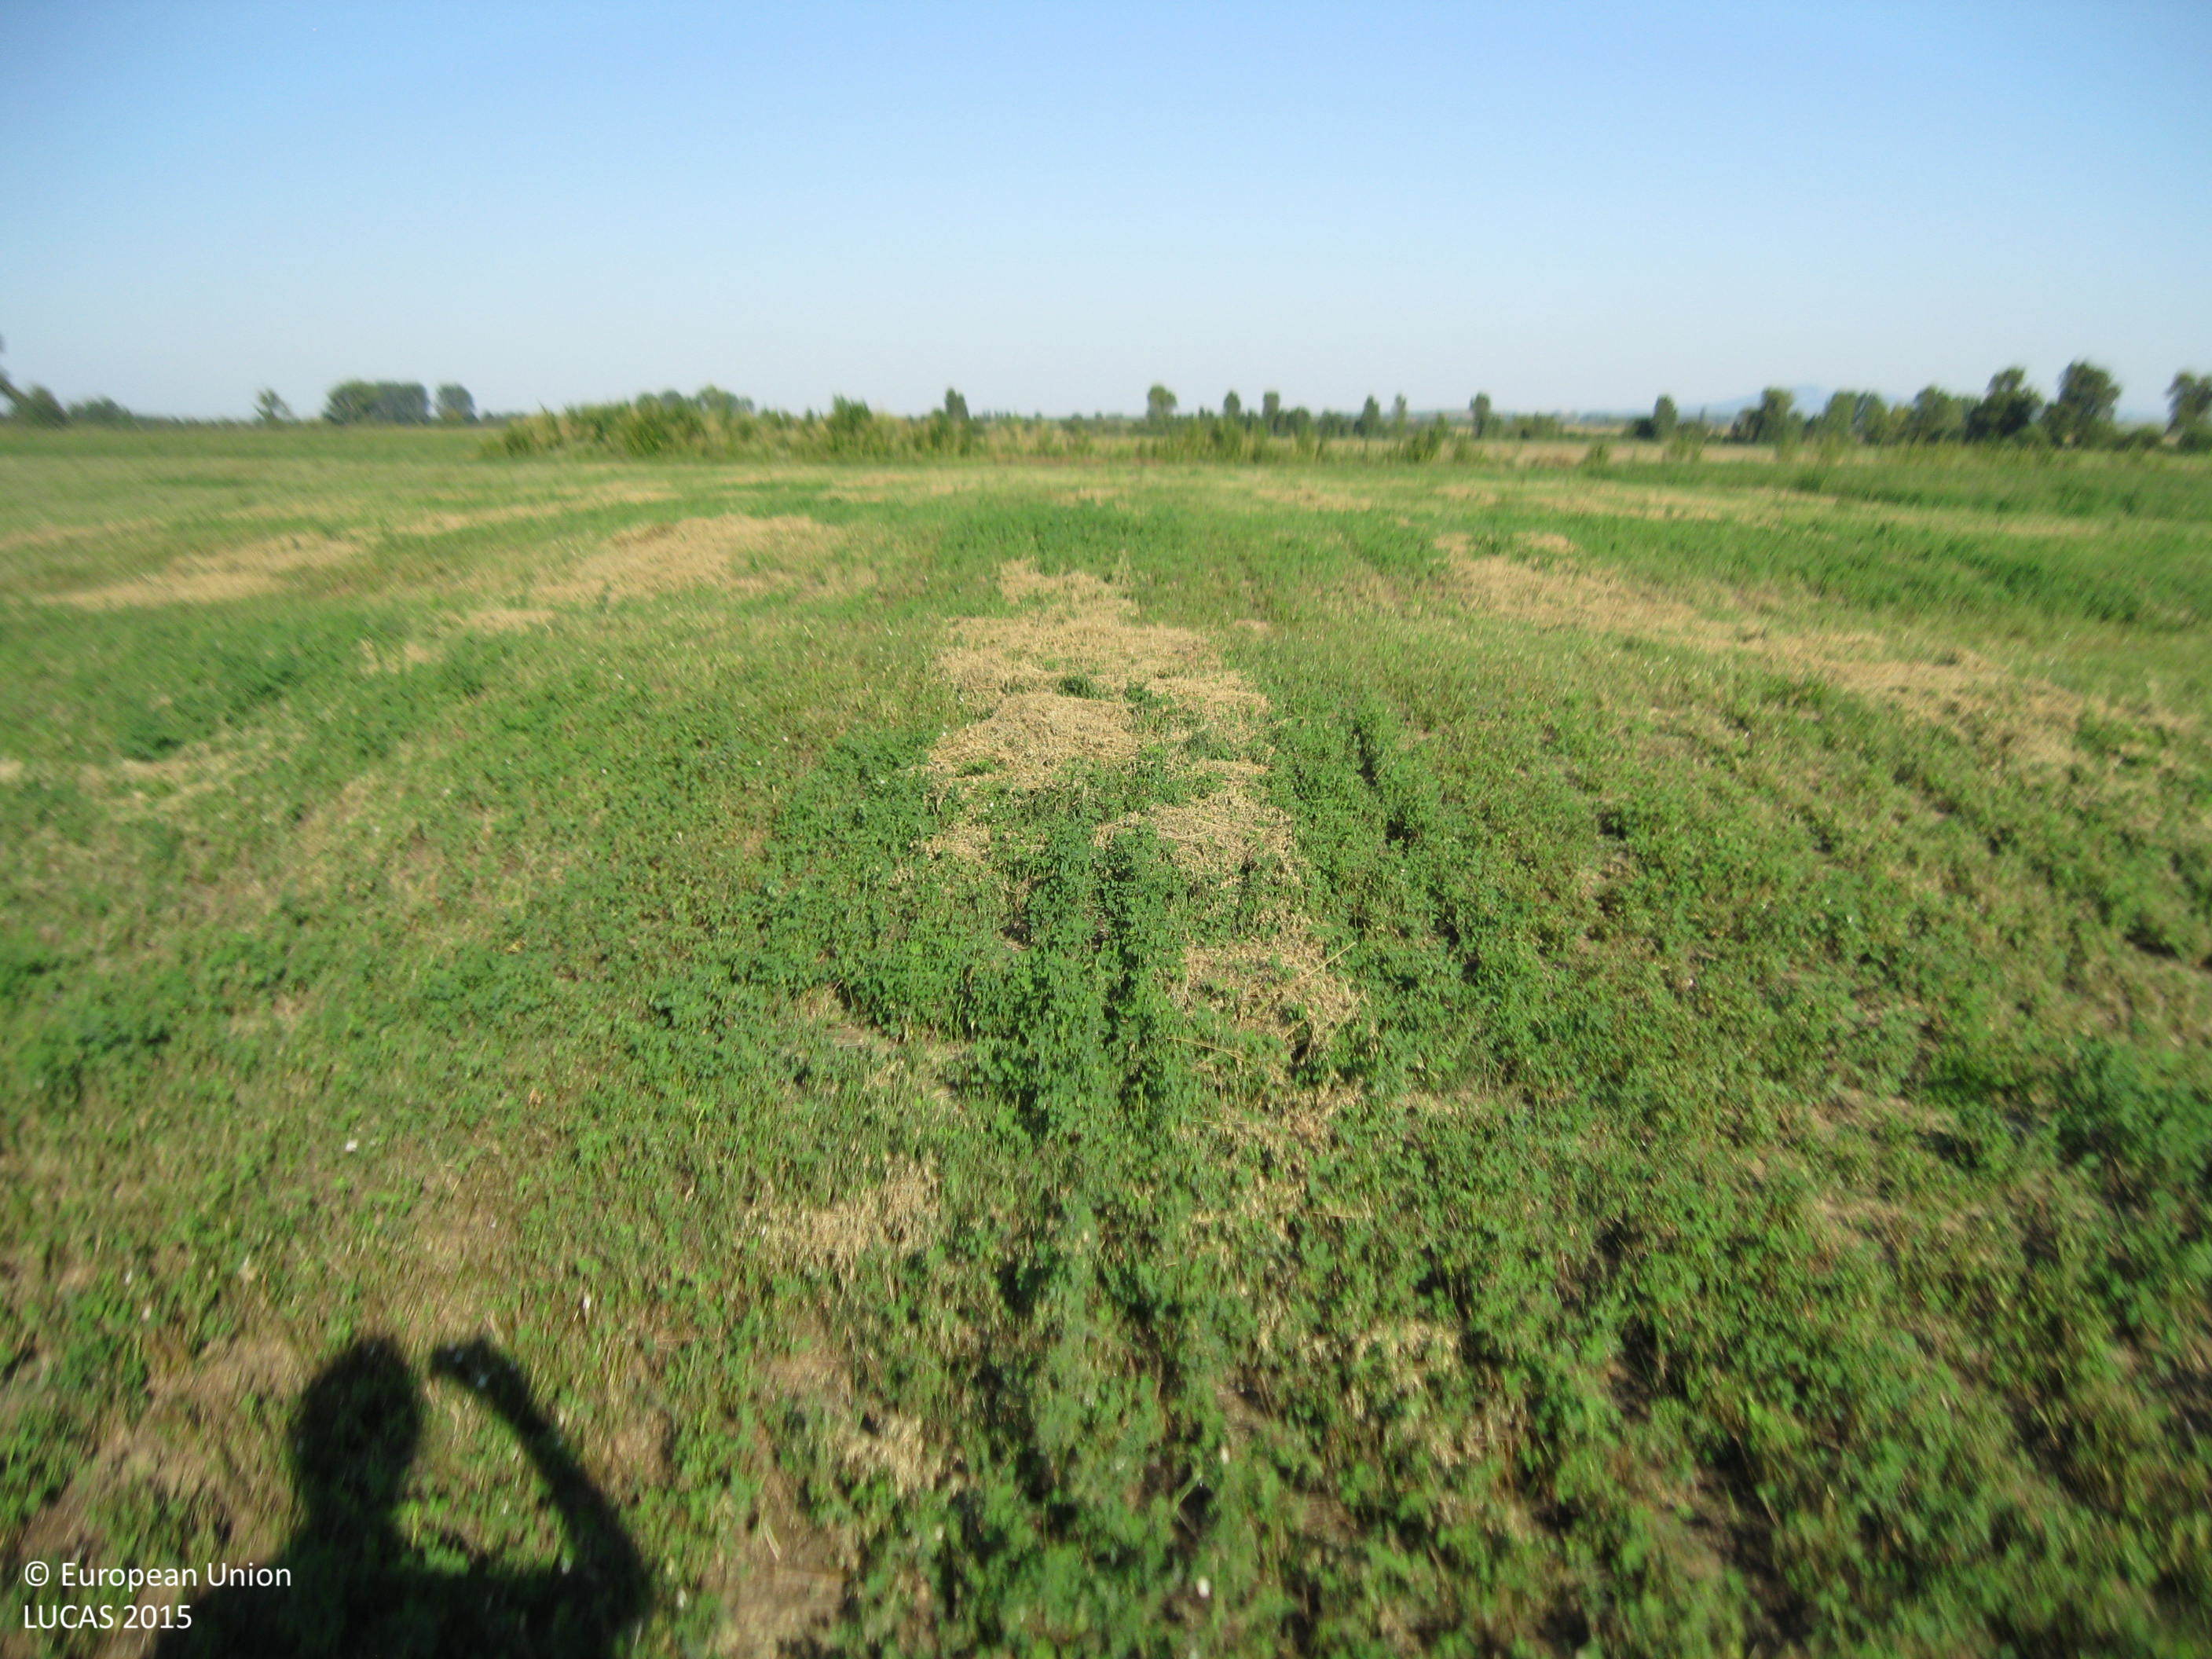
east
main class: Cropland
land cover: Lucerne
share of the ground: > 75 %
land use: Agriculture (excluding fallow land and kitchen gardens)
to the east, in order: Lucerne; Tracks; Grass margins; Common wheat
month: September
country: BG
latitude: 42.0504
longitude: 24.9515
